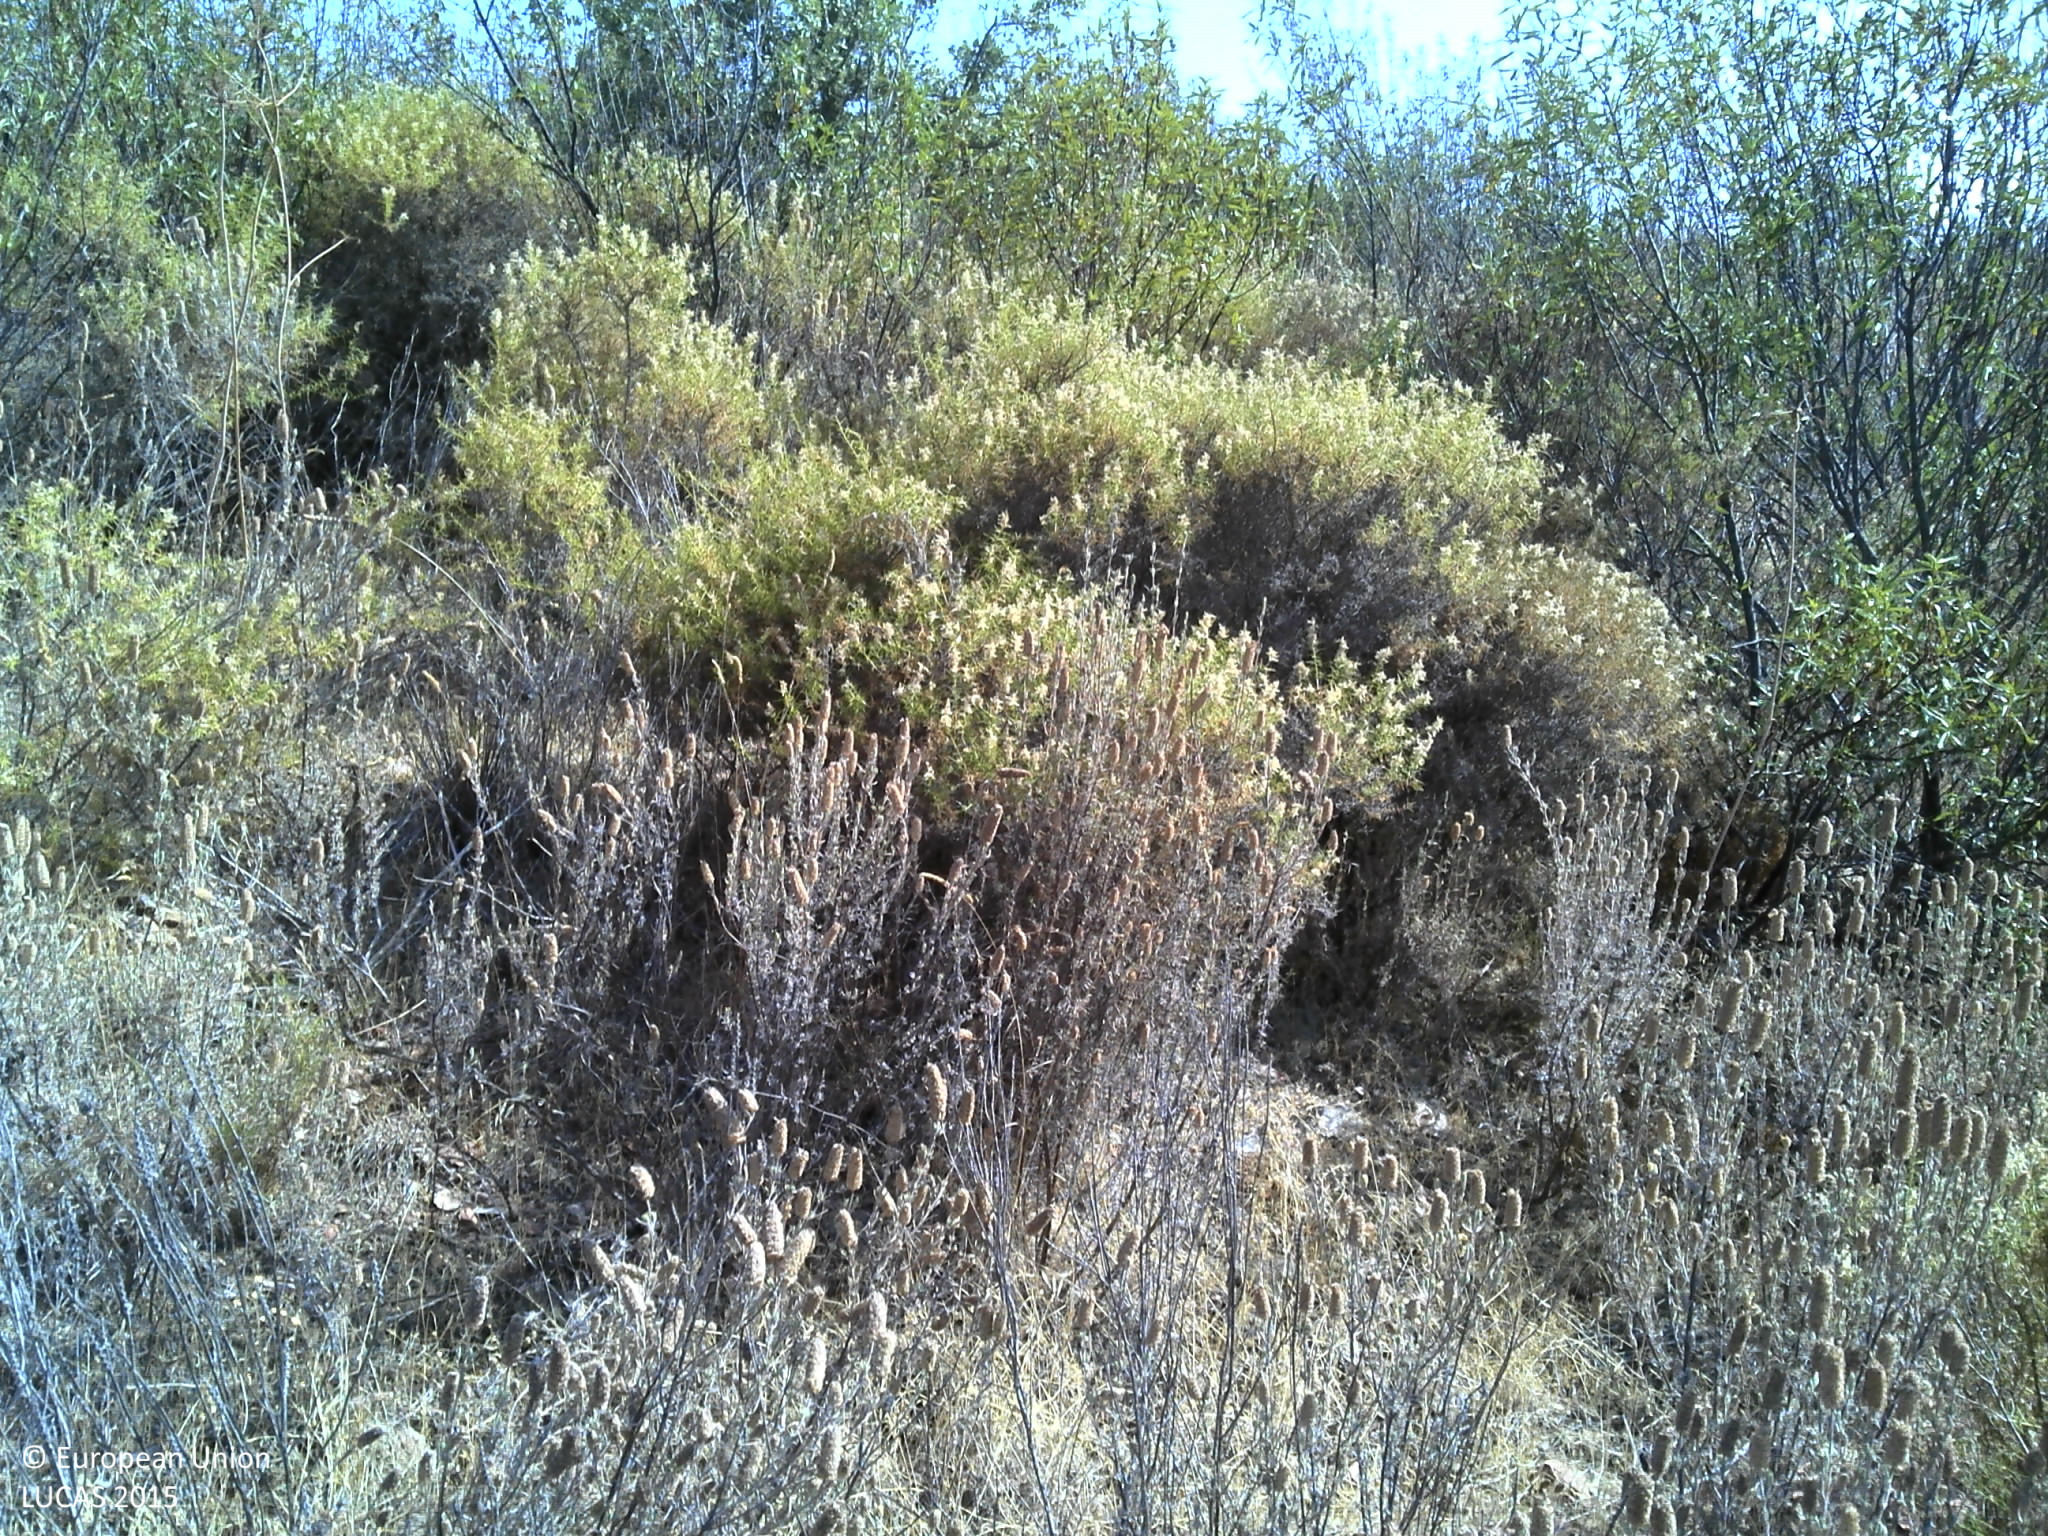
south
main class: Woodland
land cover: Broadleaved woodland
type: broadleaved evergreen forest
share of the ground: 10 - 25 %
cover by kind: broadleaved forest trees 25 %, shrubs 25 %, herbaceous plants 25 %, unconsolidated bare surface 25 %
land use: Forestry
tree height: < 5 m
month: July
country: PT
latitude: 37.8191
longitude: -7.6614
